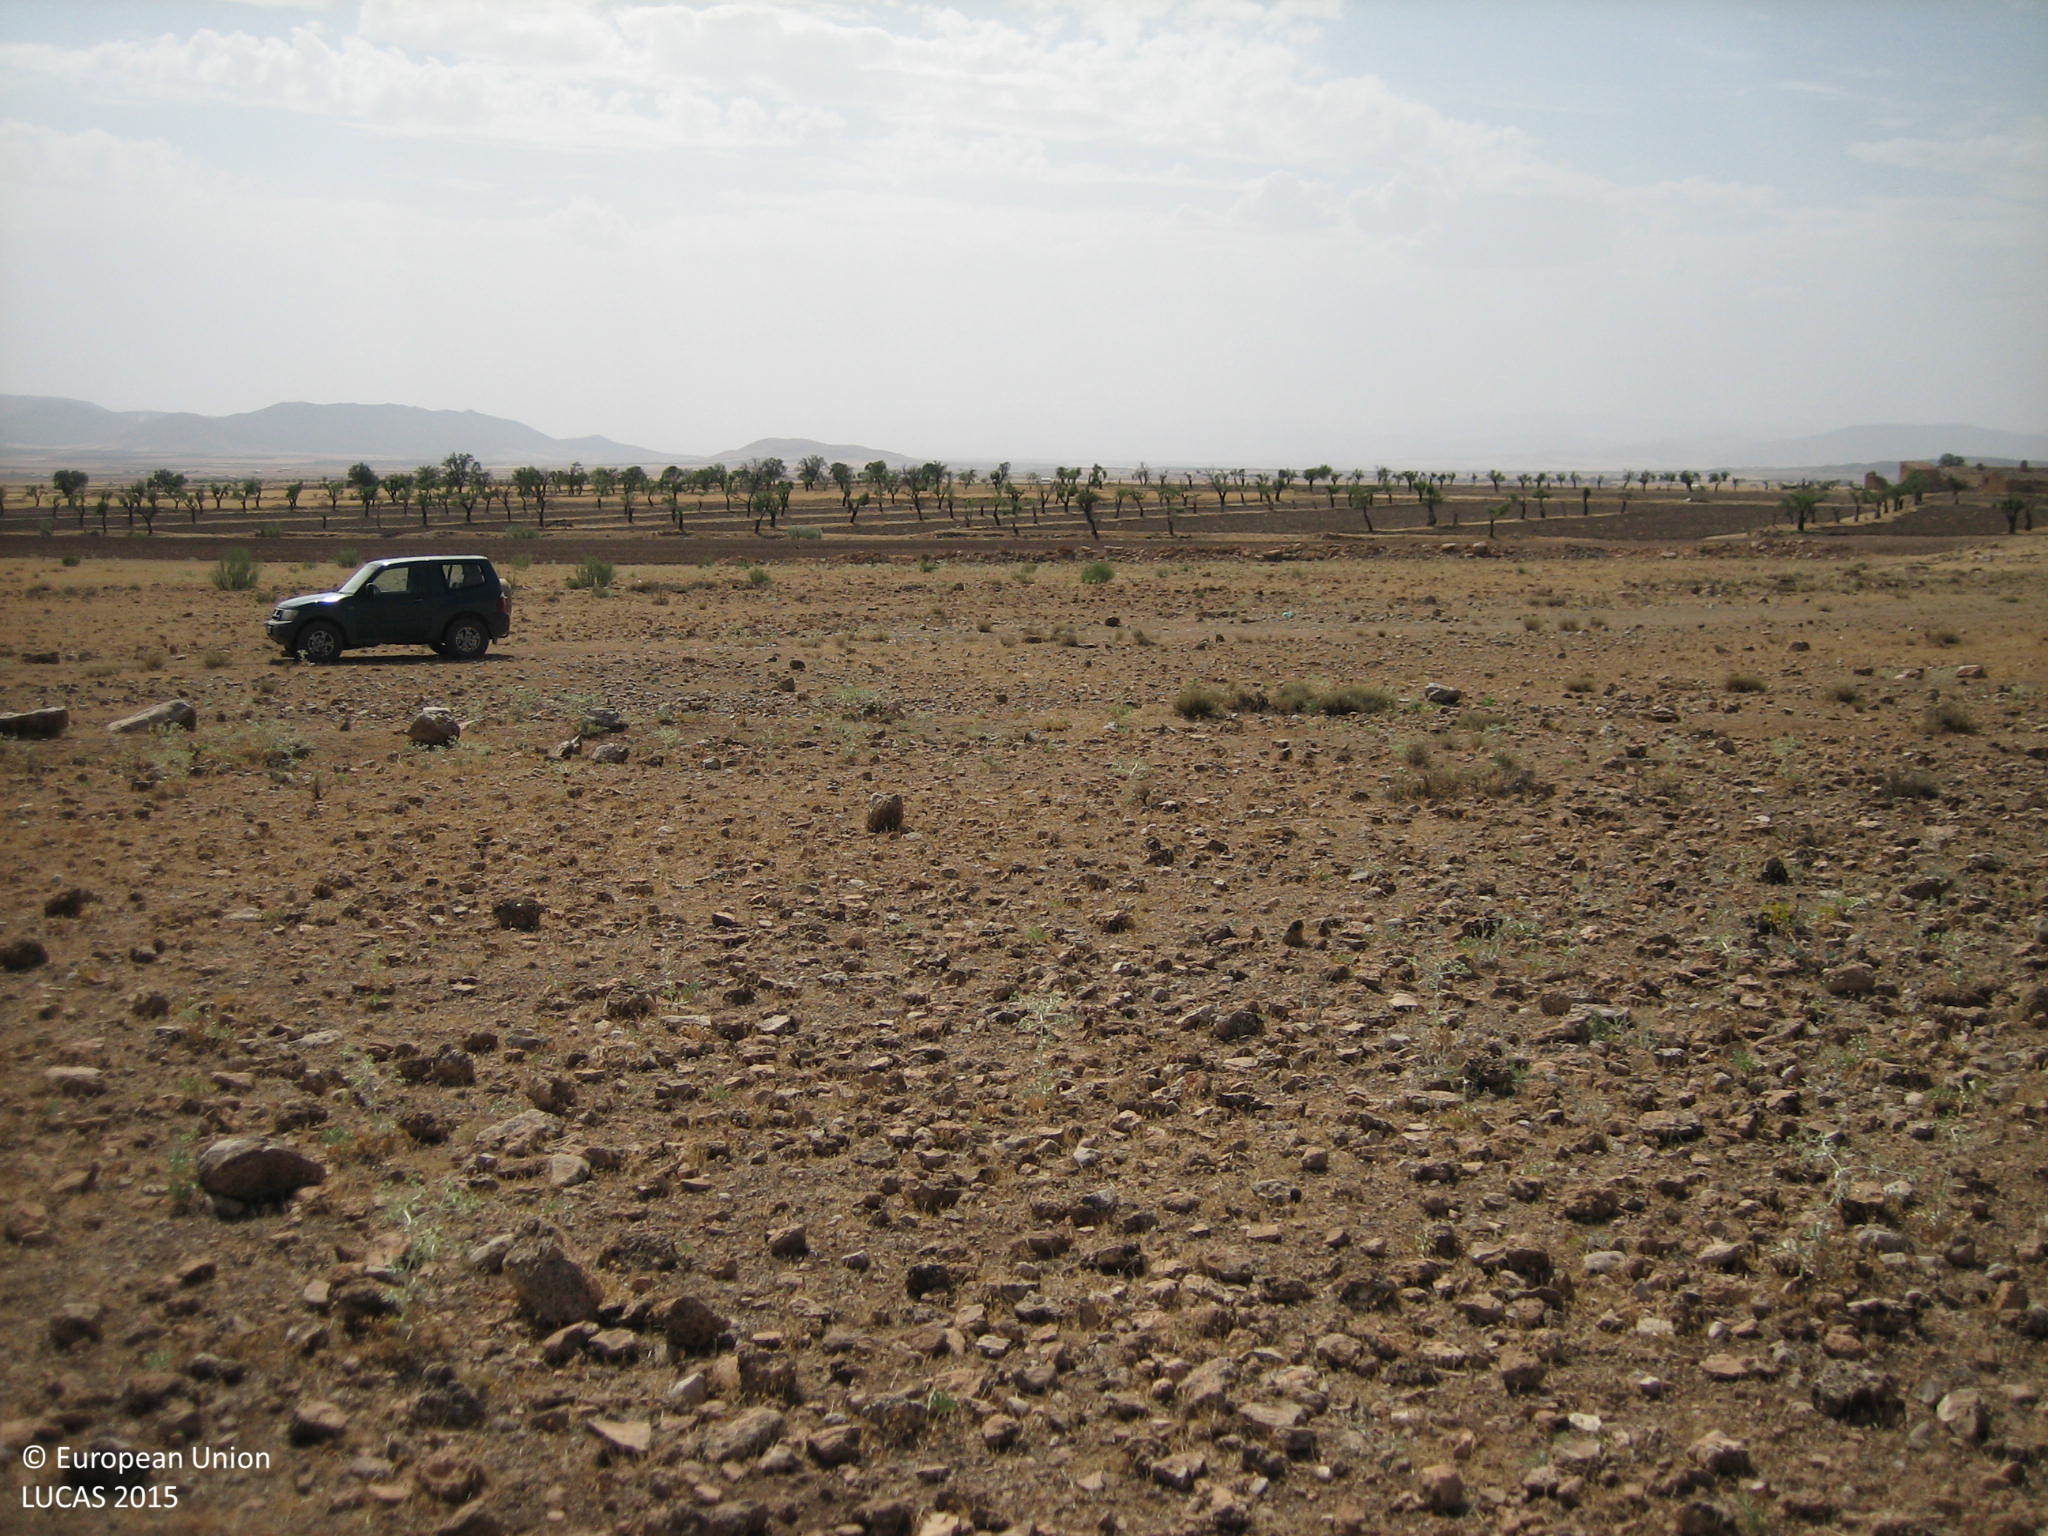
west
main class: Grassland
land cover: Grassland without tree/shrub cover
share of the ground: 10 - 25 %
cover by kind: unconsolidated bare surface 70 %, consolidated bare surface 15 %, herbaceous plants 10 %, shrubs 5 %
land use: Agriculture (excluding fallow land and kitchen gardens)
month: July
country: ES
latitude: 37.7009
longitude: -2.2698
